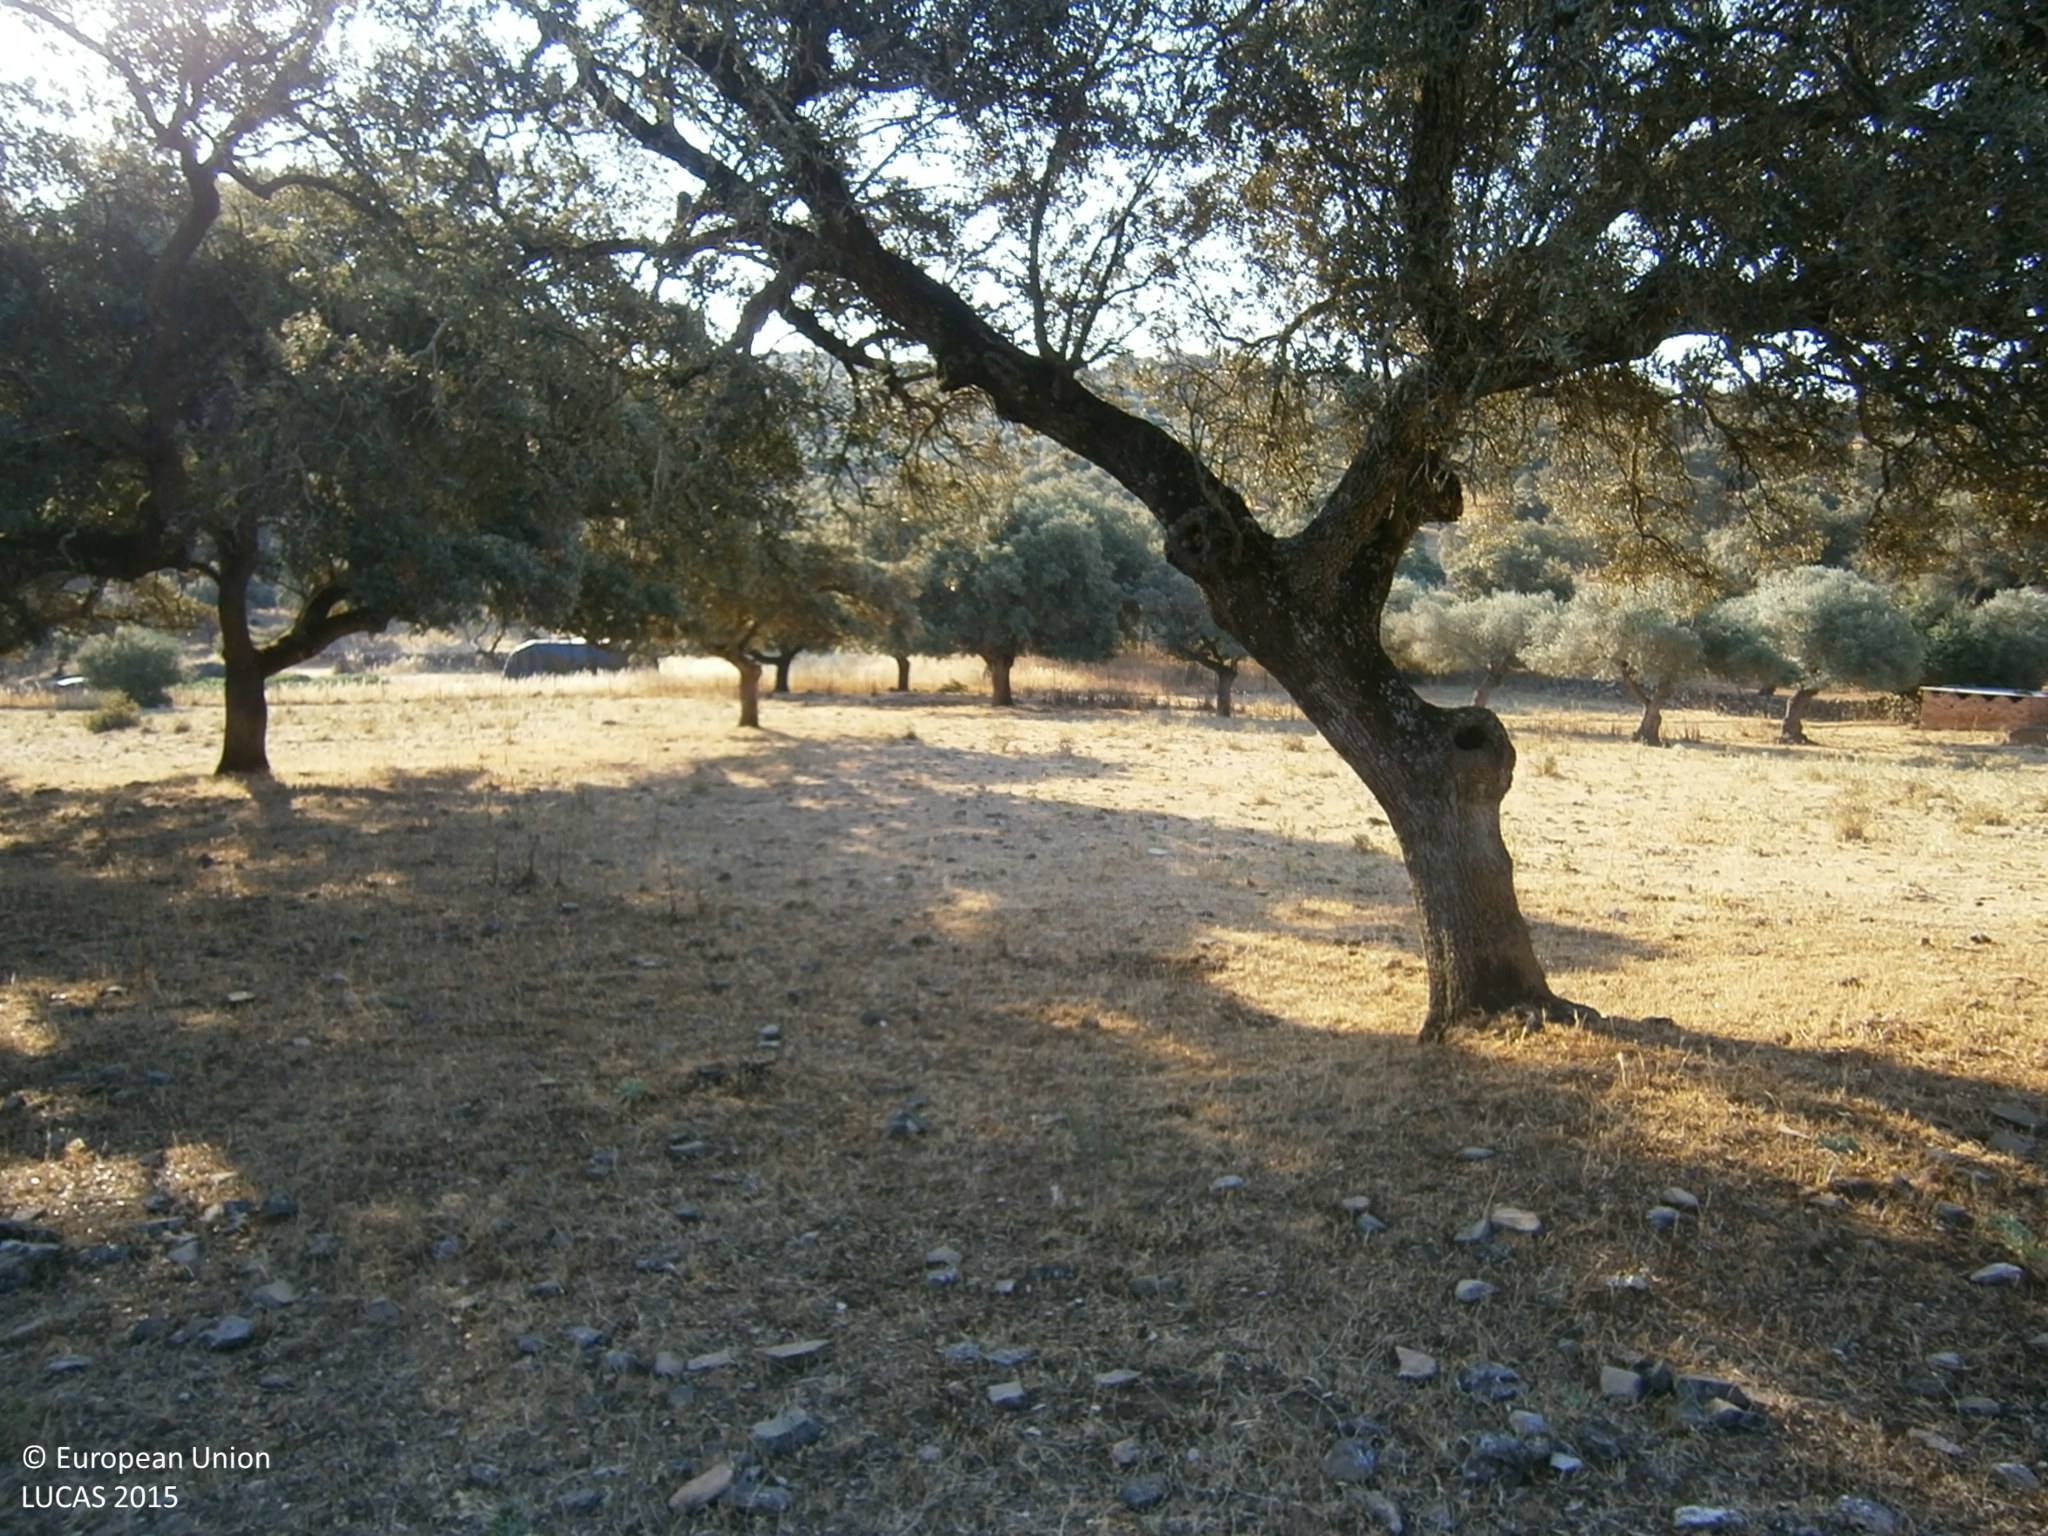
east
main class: Woodland
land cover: Broadleaved woodland
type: broadleaved evergreen forest
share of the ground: > 75 %
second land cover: Spontaneously vegetated surfaces
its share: 50 - 75 %
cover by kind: herbaceous plants 70 %, broadleaved forest trees 10 %, unconsolidated bare surface 10 %, shrubs 5 %
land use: Forestry
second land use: Agriculture (excluding fallow land and kitchen gardens)
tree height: > 5 m
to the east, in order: Broadleaved woodland; Spontaneously vegetated surfaces; Grassland with sparse tree/shrub cover; Fences; Broadleaved woodland; Dry stone walls; Tracks; Dry stone walls; Broadleaved woodland; Dry stone walls; Broadleaved woodland
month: June
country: ES
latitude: 38.5839
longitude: -6.8100
